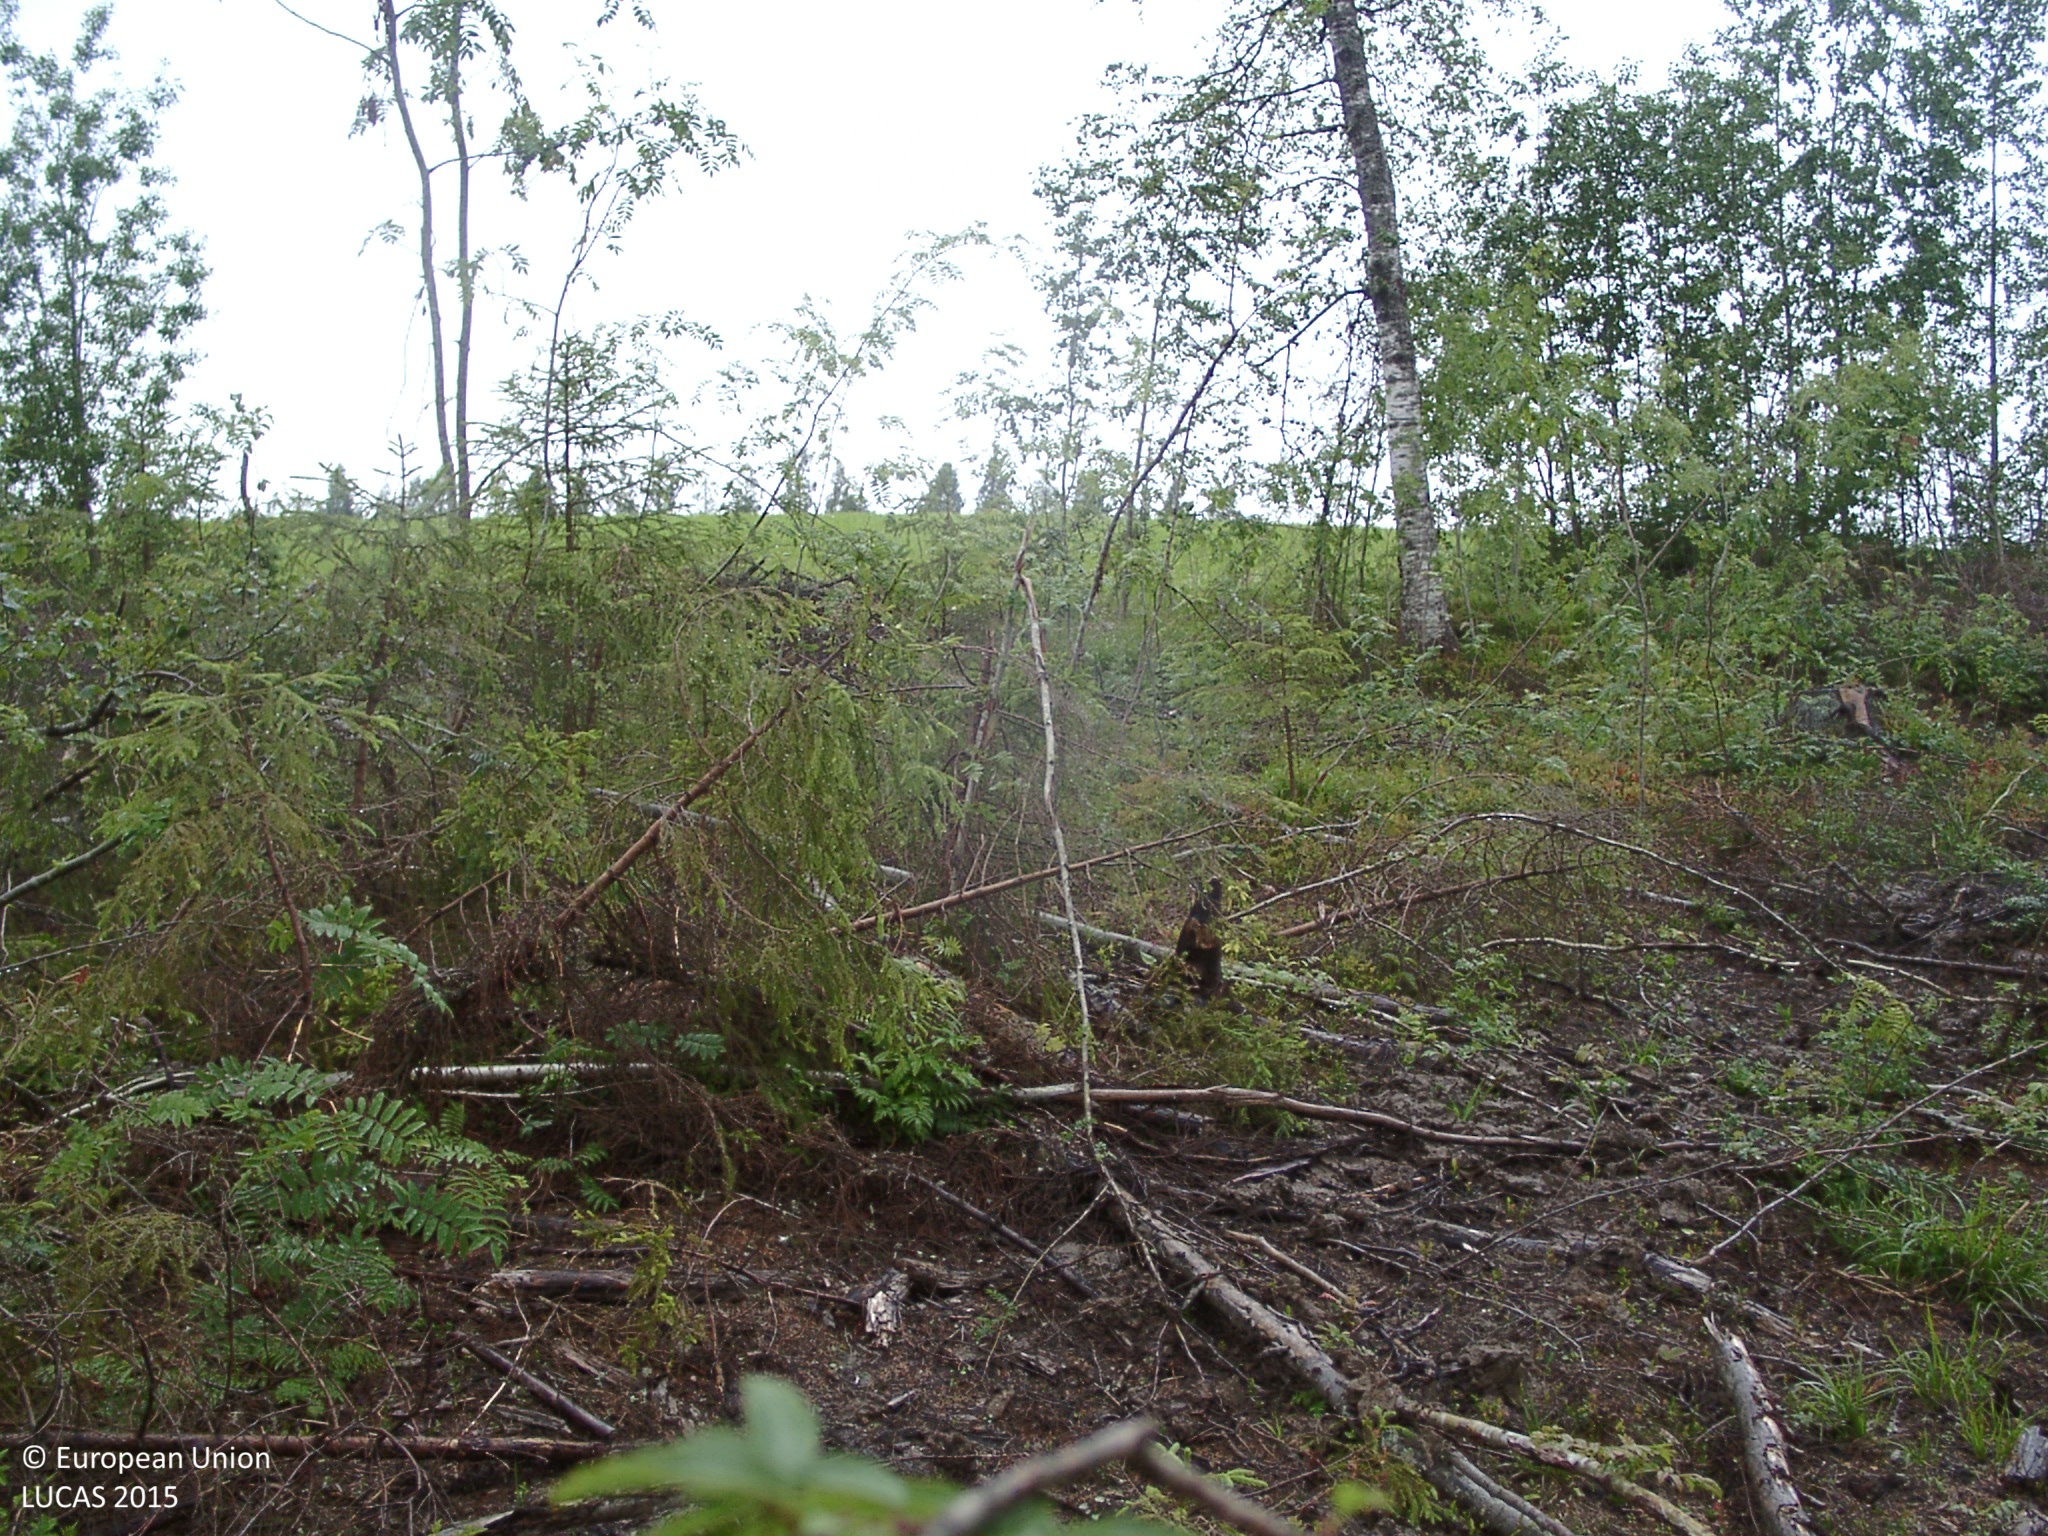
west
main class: Shrubland
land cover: Shrubland with sparse tree cover
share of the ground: 10 - 25 %
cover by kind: unconsolidated bare surface 40 %, shrubs 10 %, broadleaved forest trees 5 %, herbaceous plants 5 %
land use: Forestry
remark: Clear cut
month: July
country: FI
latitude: 62.3060
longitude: 25.4459
